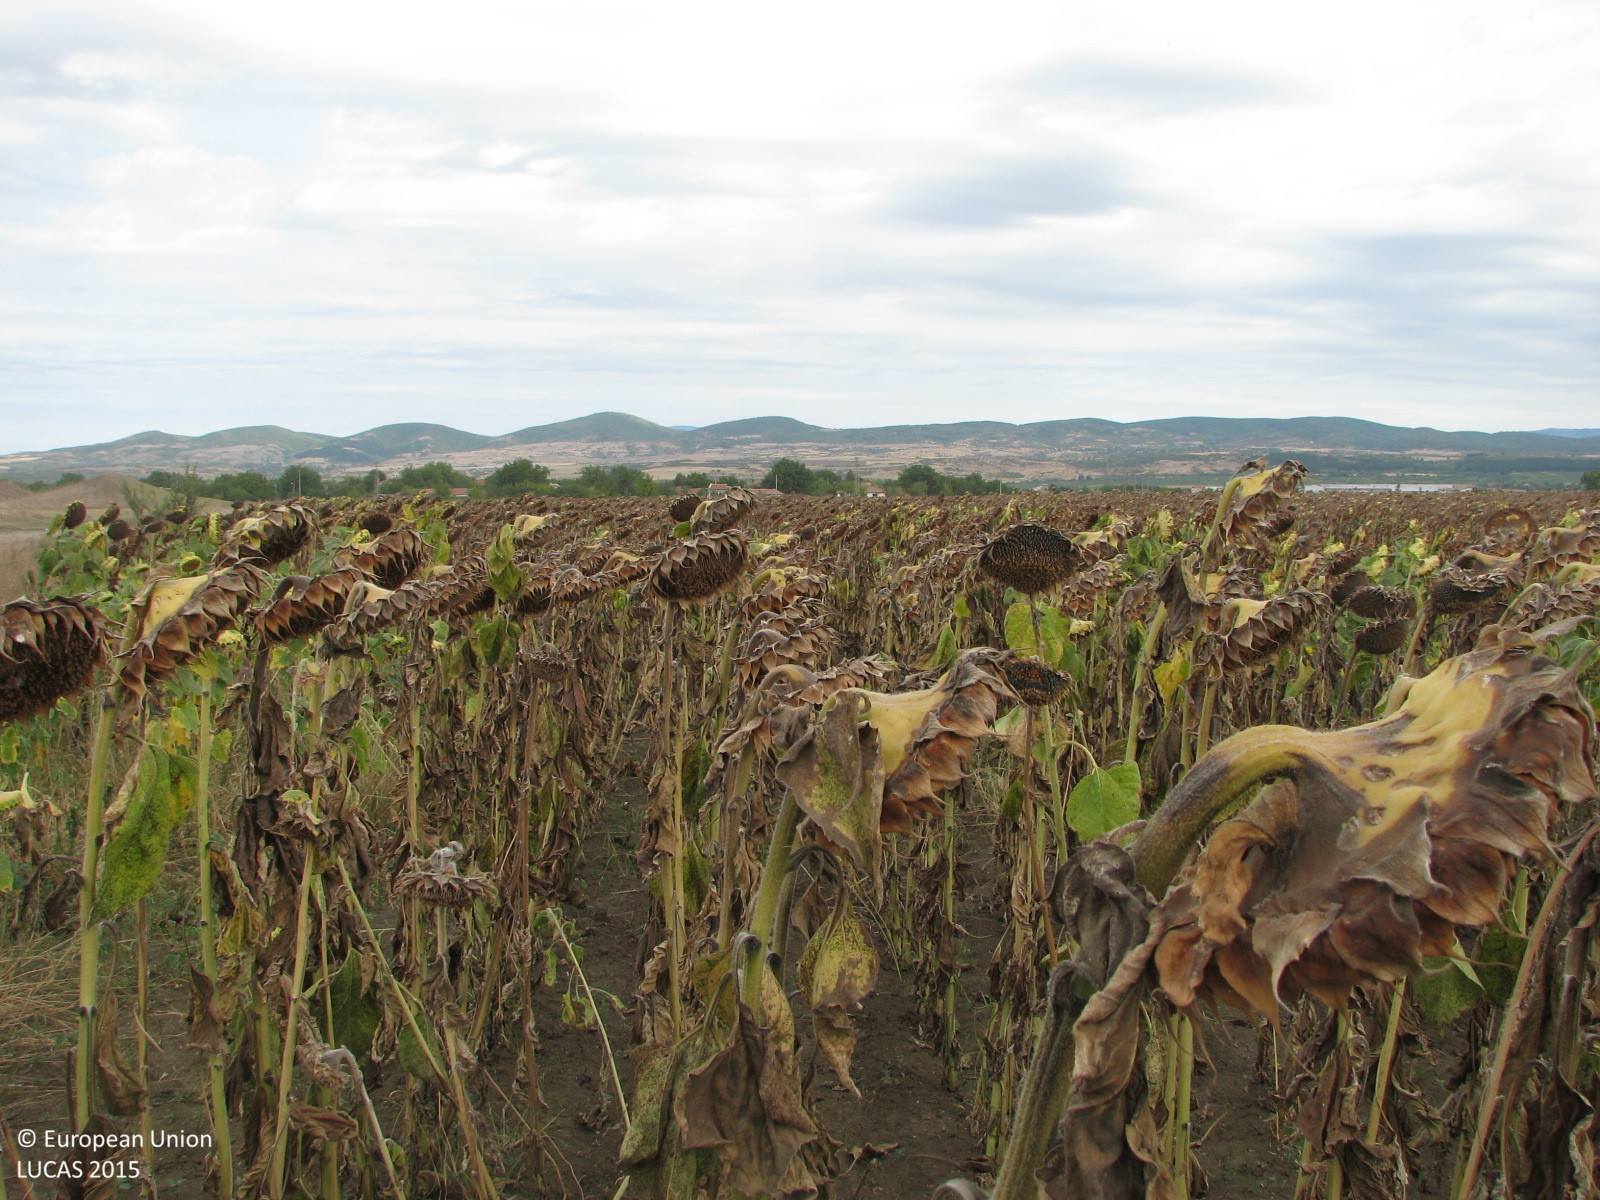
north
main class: Cropland
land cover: Sunflower
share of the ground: > 75 %
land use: Agriculture (excluding fallow land and kitchen gardens)
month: September
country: BG
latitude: 42.5157
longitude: 26.0886
